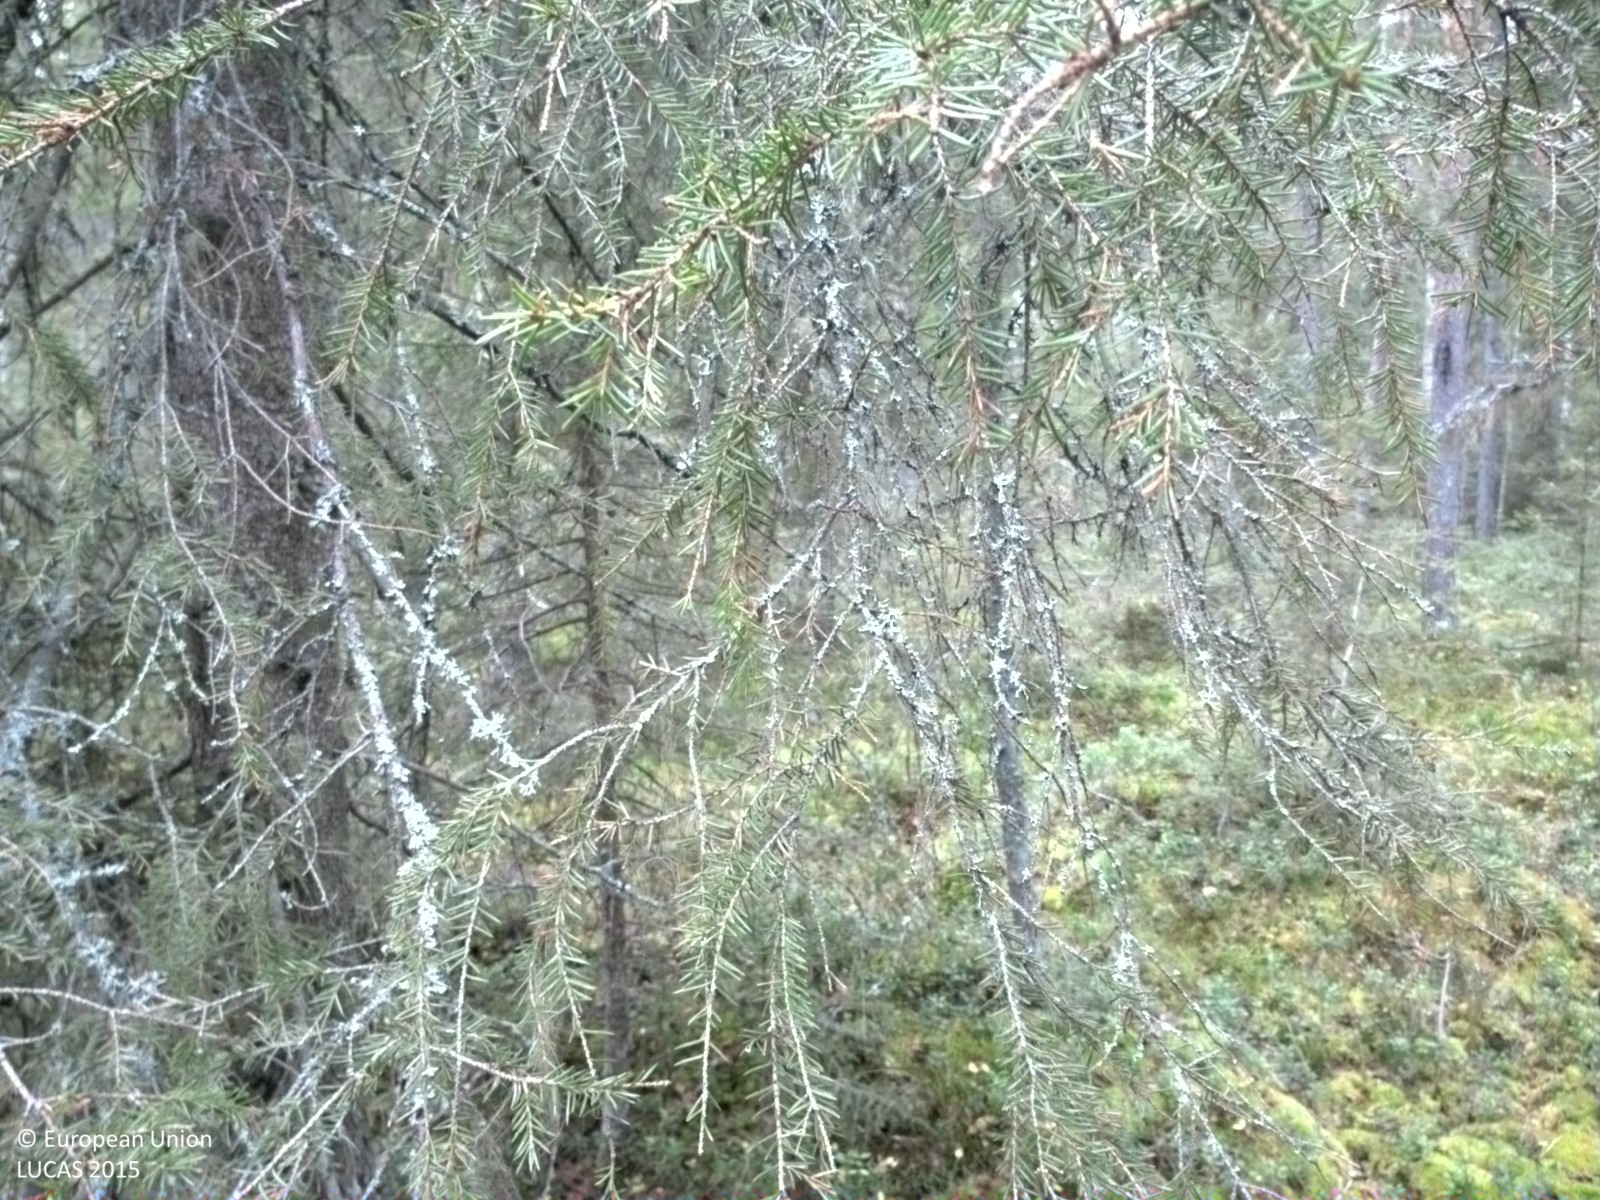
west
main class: Woodland
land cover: Spruce dominated mixed woodland
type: boreal forest
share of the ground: 50 - 75 %
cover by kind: coniferous forest trees 40 %, shrubs 40 %, broadleaved forest trees 15 %, lichens and mosses 5 %
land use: Forestry
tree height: > 5 m
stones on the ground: < 10 %
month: October
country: SE
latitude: 65.6577
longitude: 21.0358
